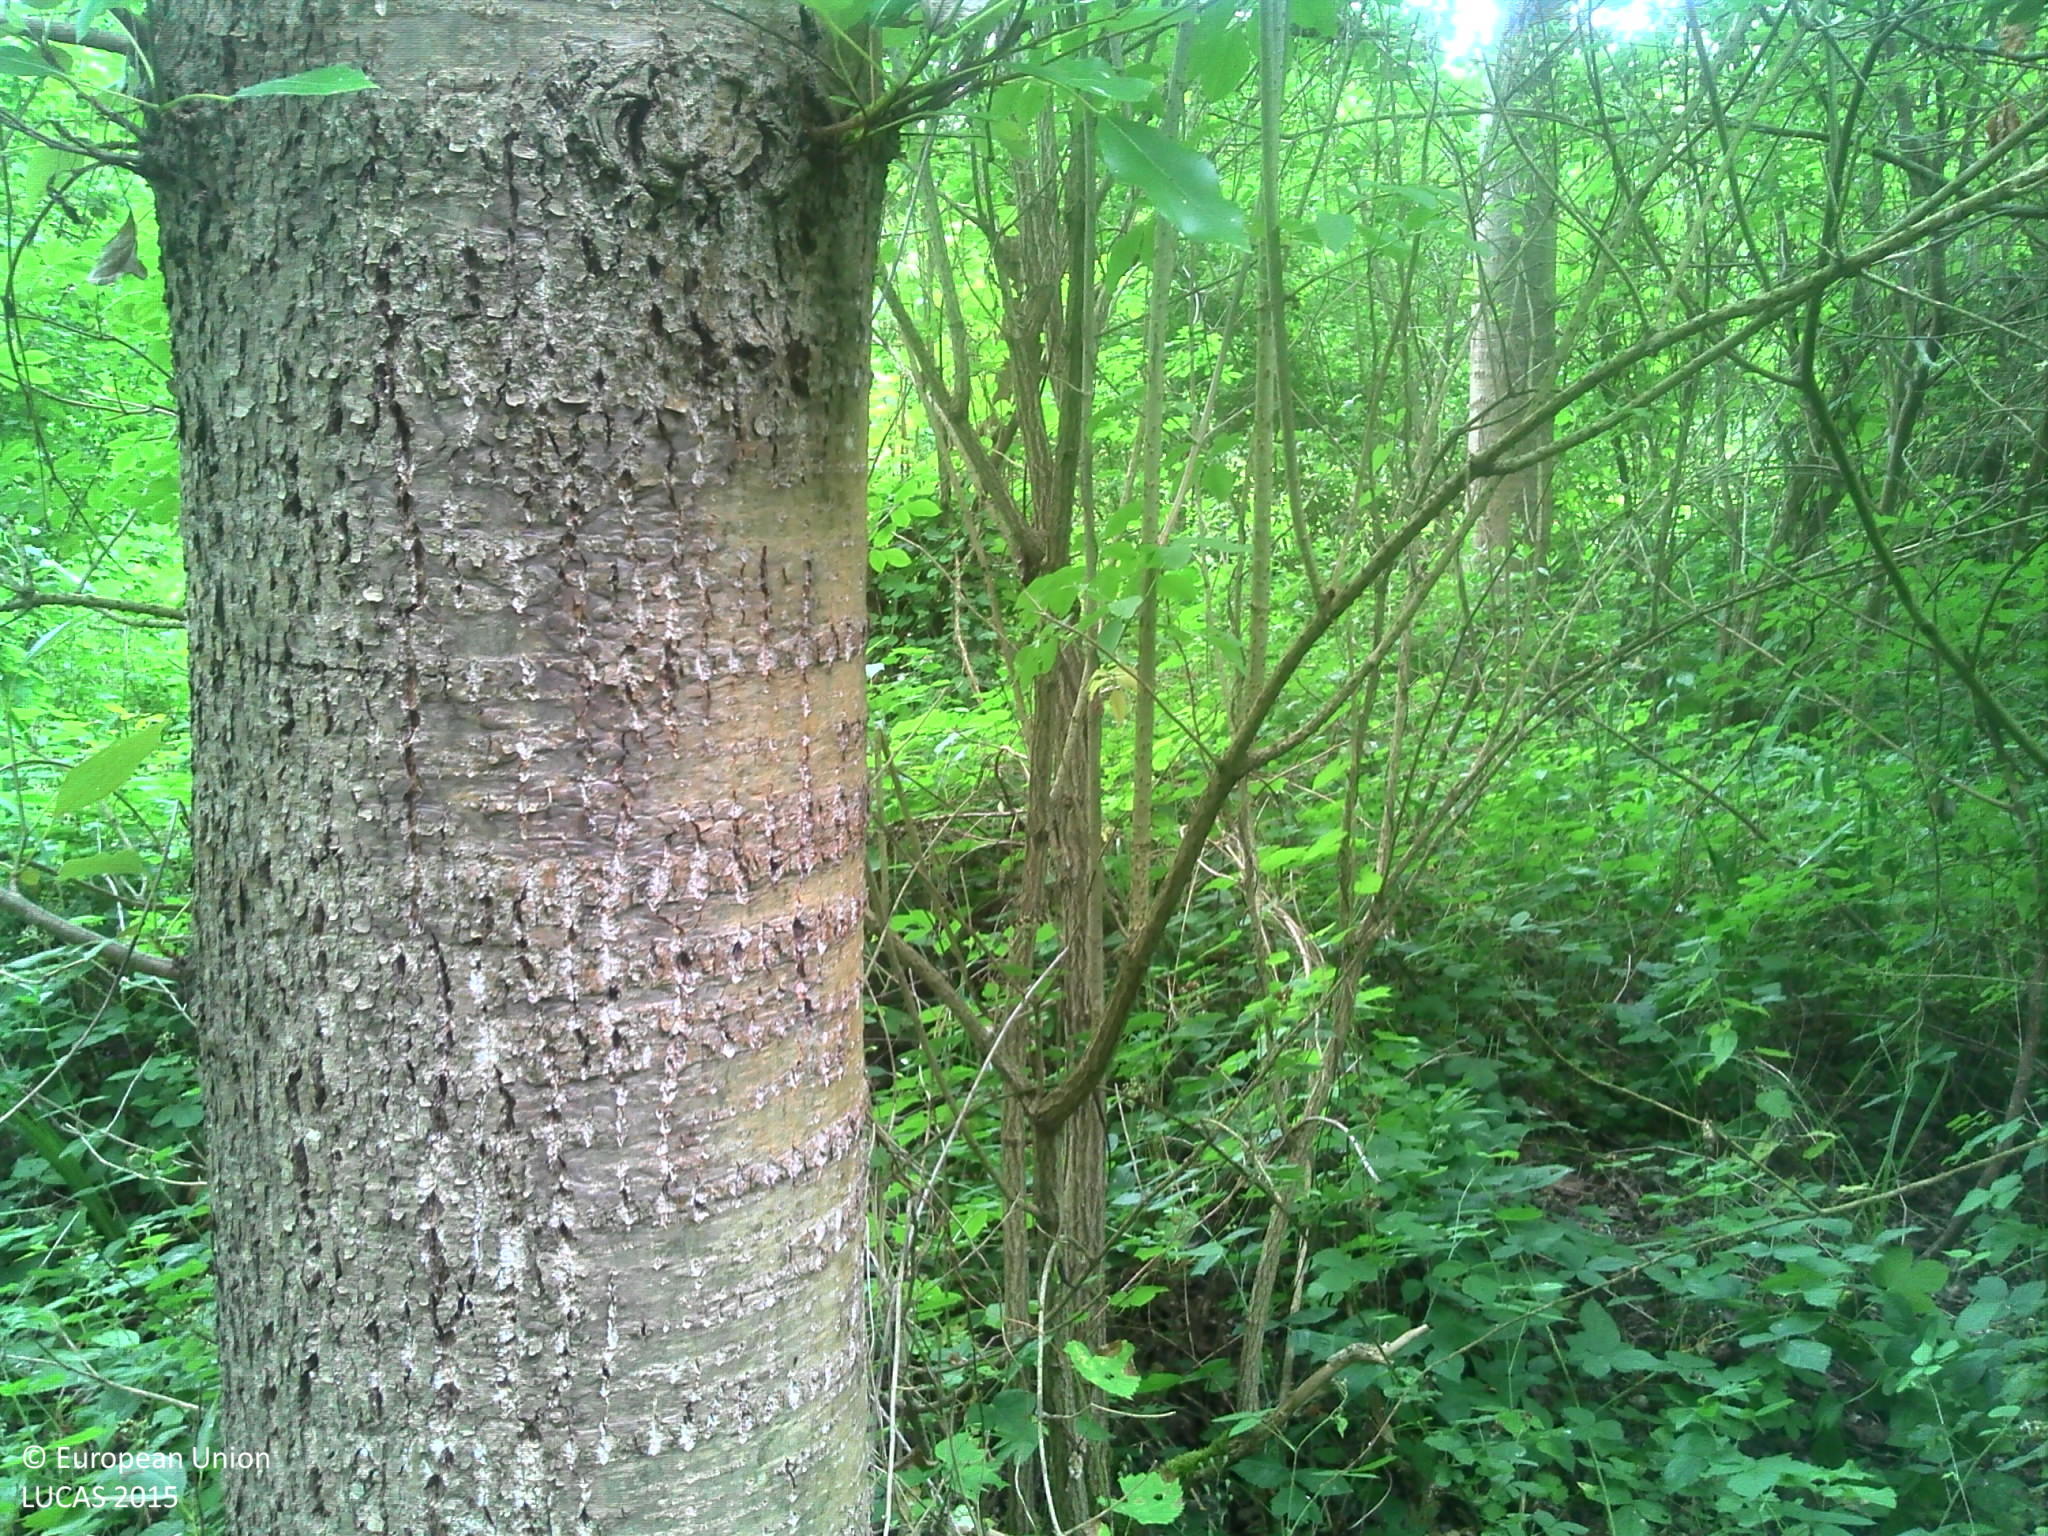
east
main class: Woodland
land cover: Broadleaved woodland
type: floodplain forest
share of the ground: > 75 %
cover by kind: broadleaved forest trees 85 %, herbaceous plants 15 %
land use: Forestry
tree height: > 5 m
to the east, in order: Broadleaved woodland
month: July
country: FR
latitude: 49.1936
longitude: 3.3095
